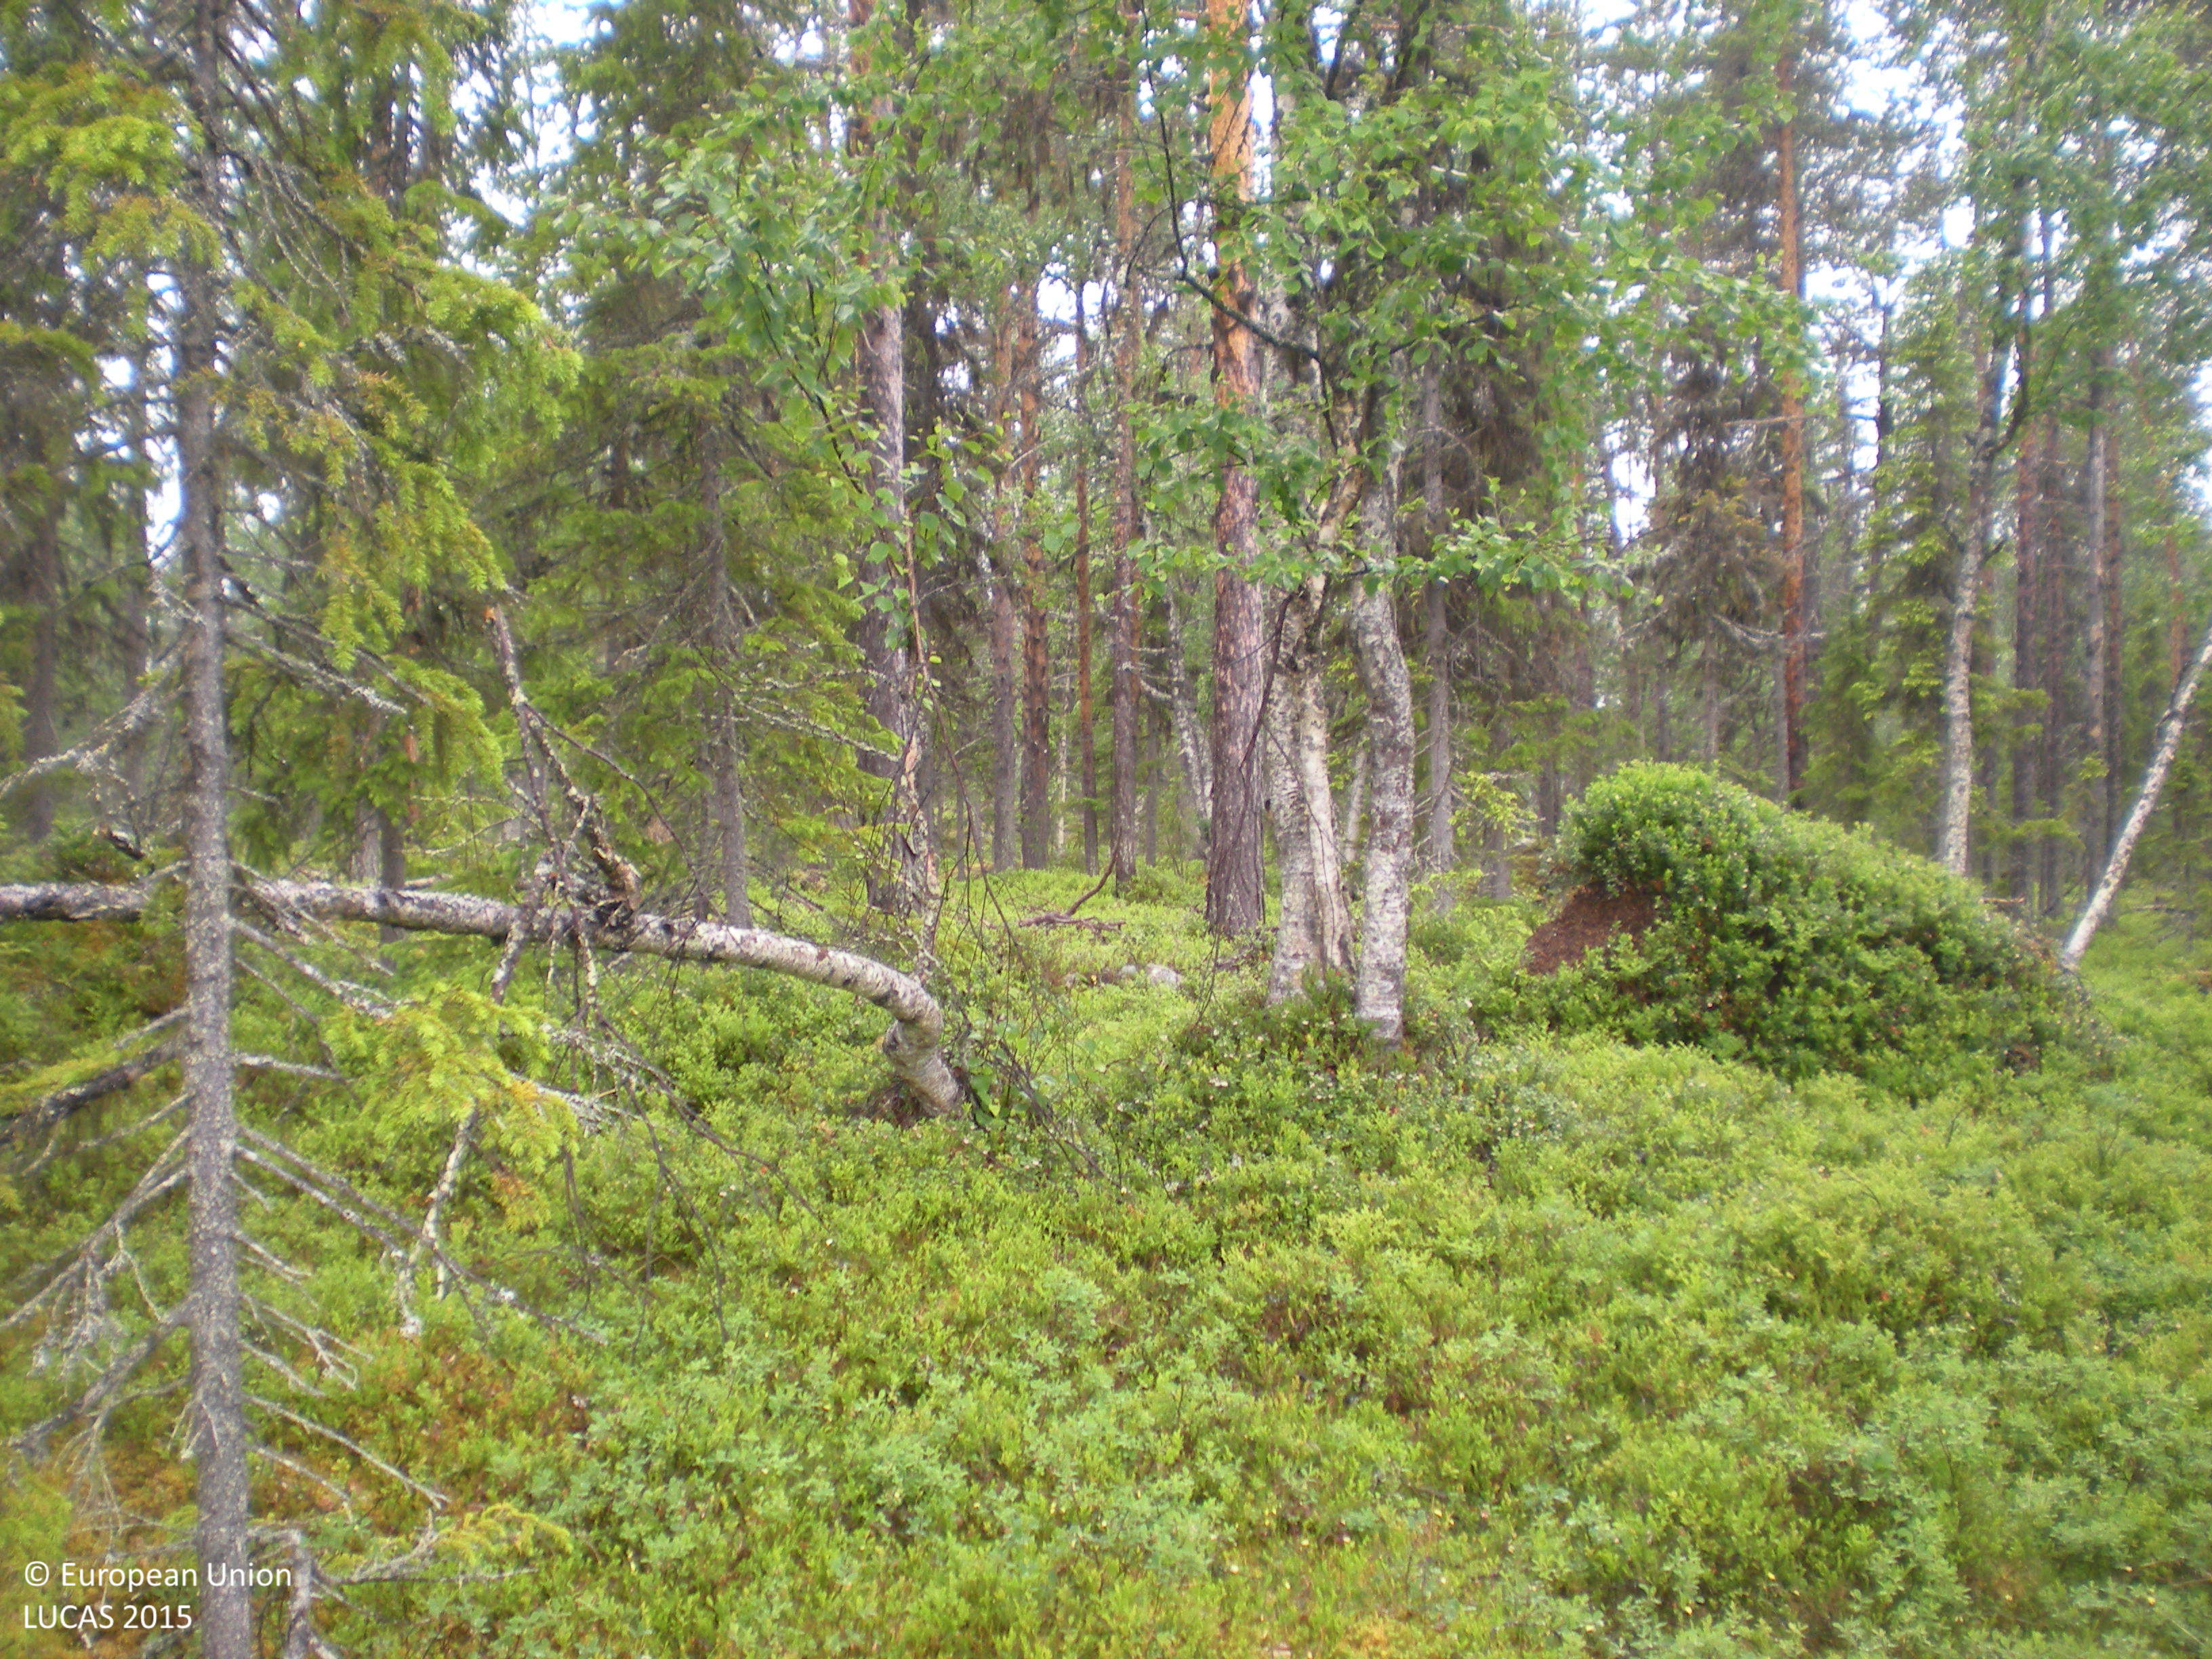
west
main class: Woodland
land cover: Other mixed woodland
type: boreal forest
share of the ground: 25 - 50 %
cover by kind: coniferous forest trees 35 %, shrubs 25 %, lichens and mosses 20 %, broadleaved forest trees 15 %, herbaceous plants 5 %
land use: Forestry
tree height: > 5 m
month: July
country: SE
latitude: 65.8070
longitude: 17.7642
